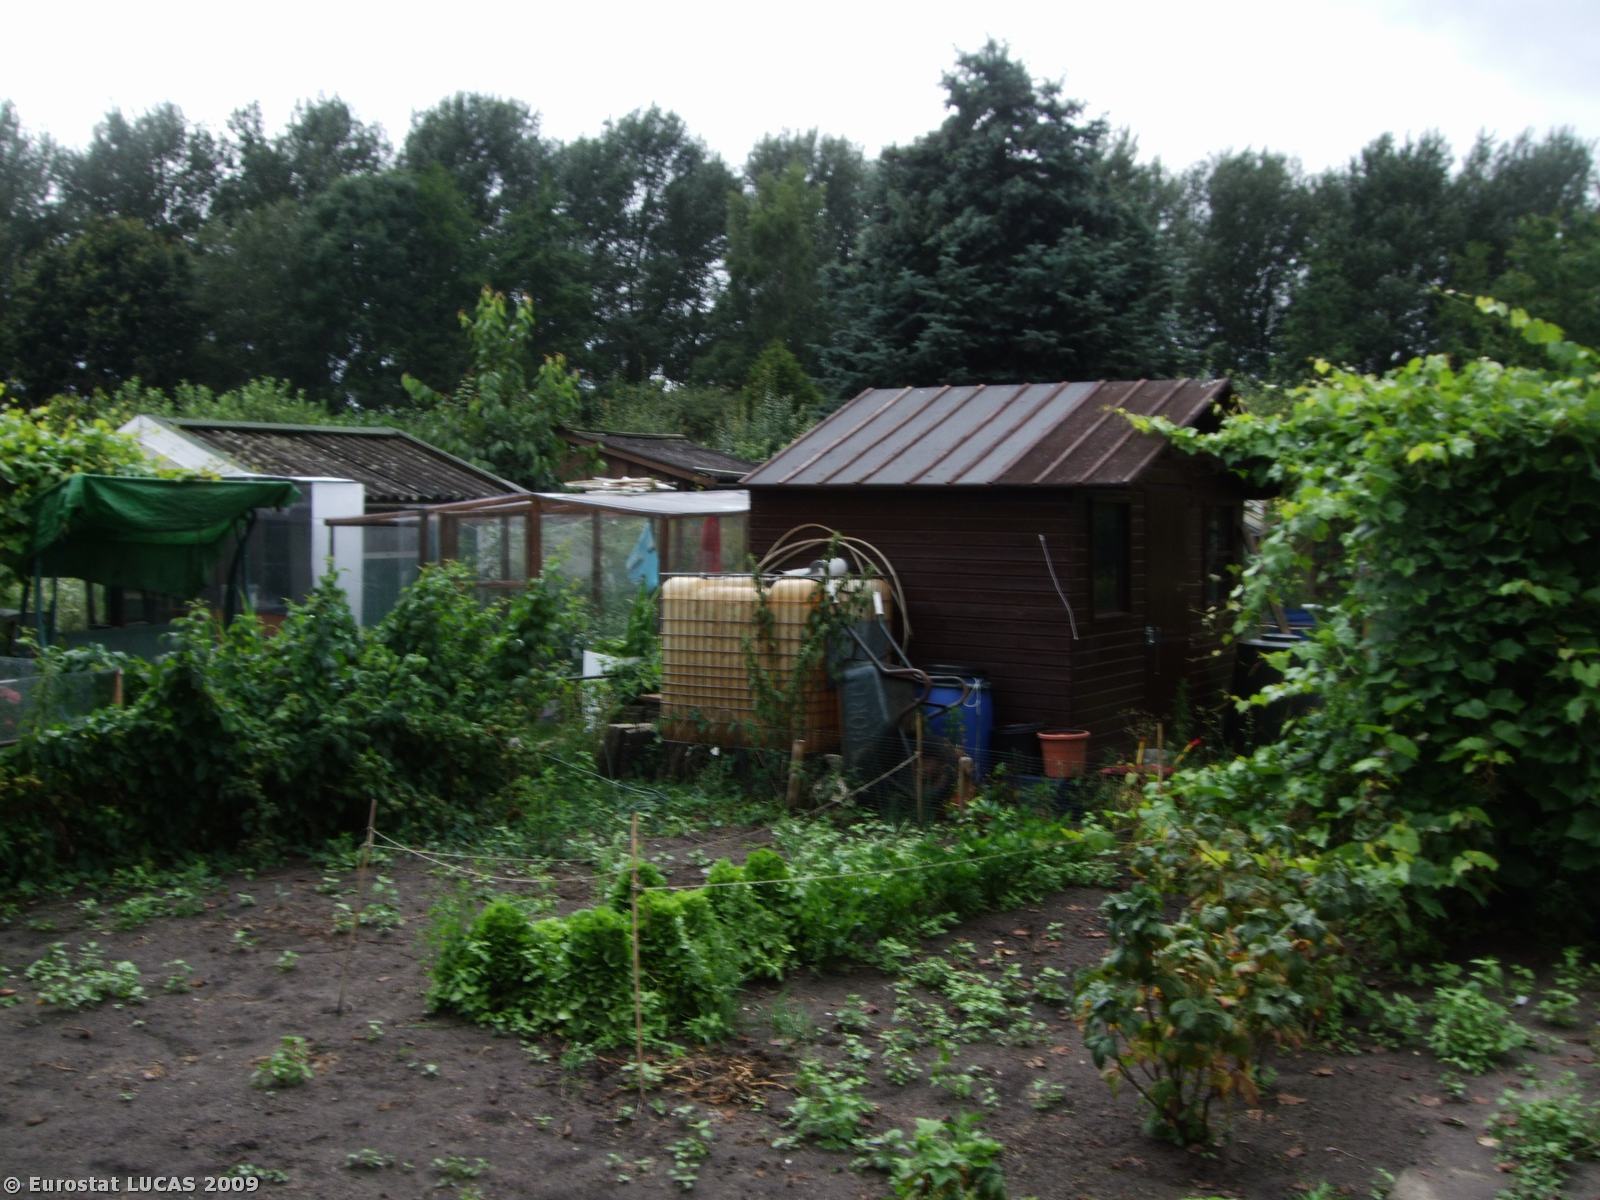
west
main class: Artificial land
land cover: Buildings with 1 to 3 floors
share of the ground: 10 - 25 %
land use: Amenities, museums, leisure
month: July
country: NL
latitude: 51.4714
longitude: 5.6940
